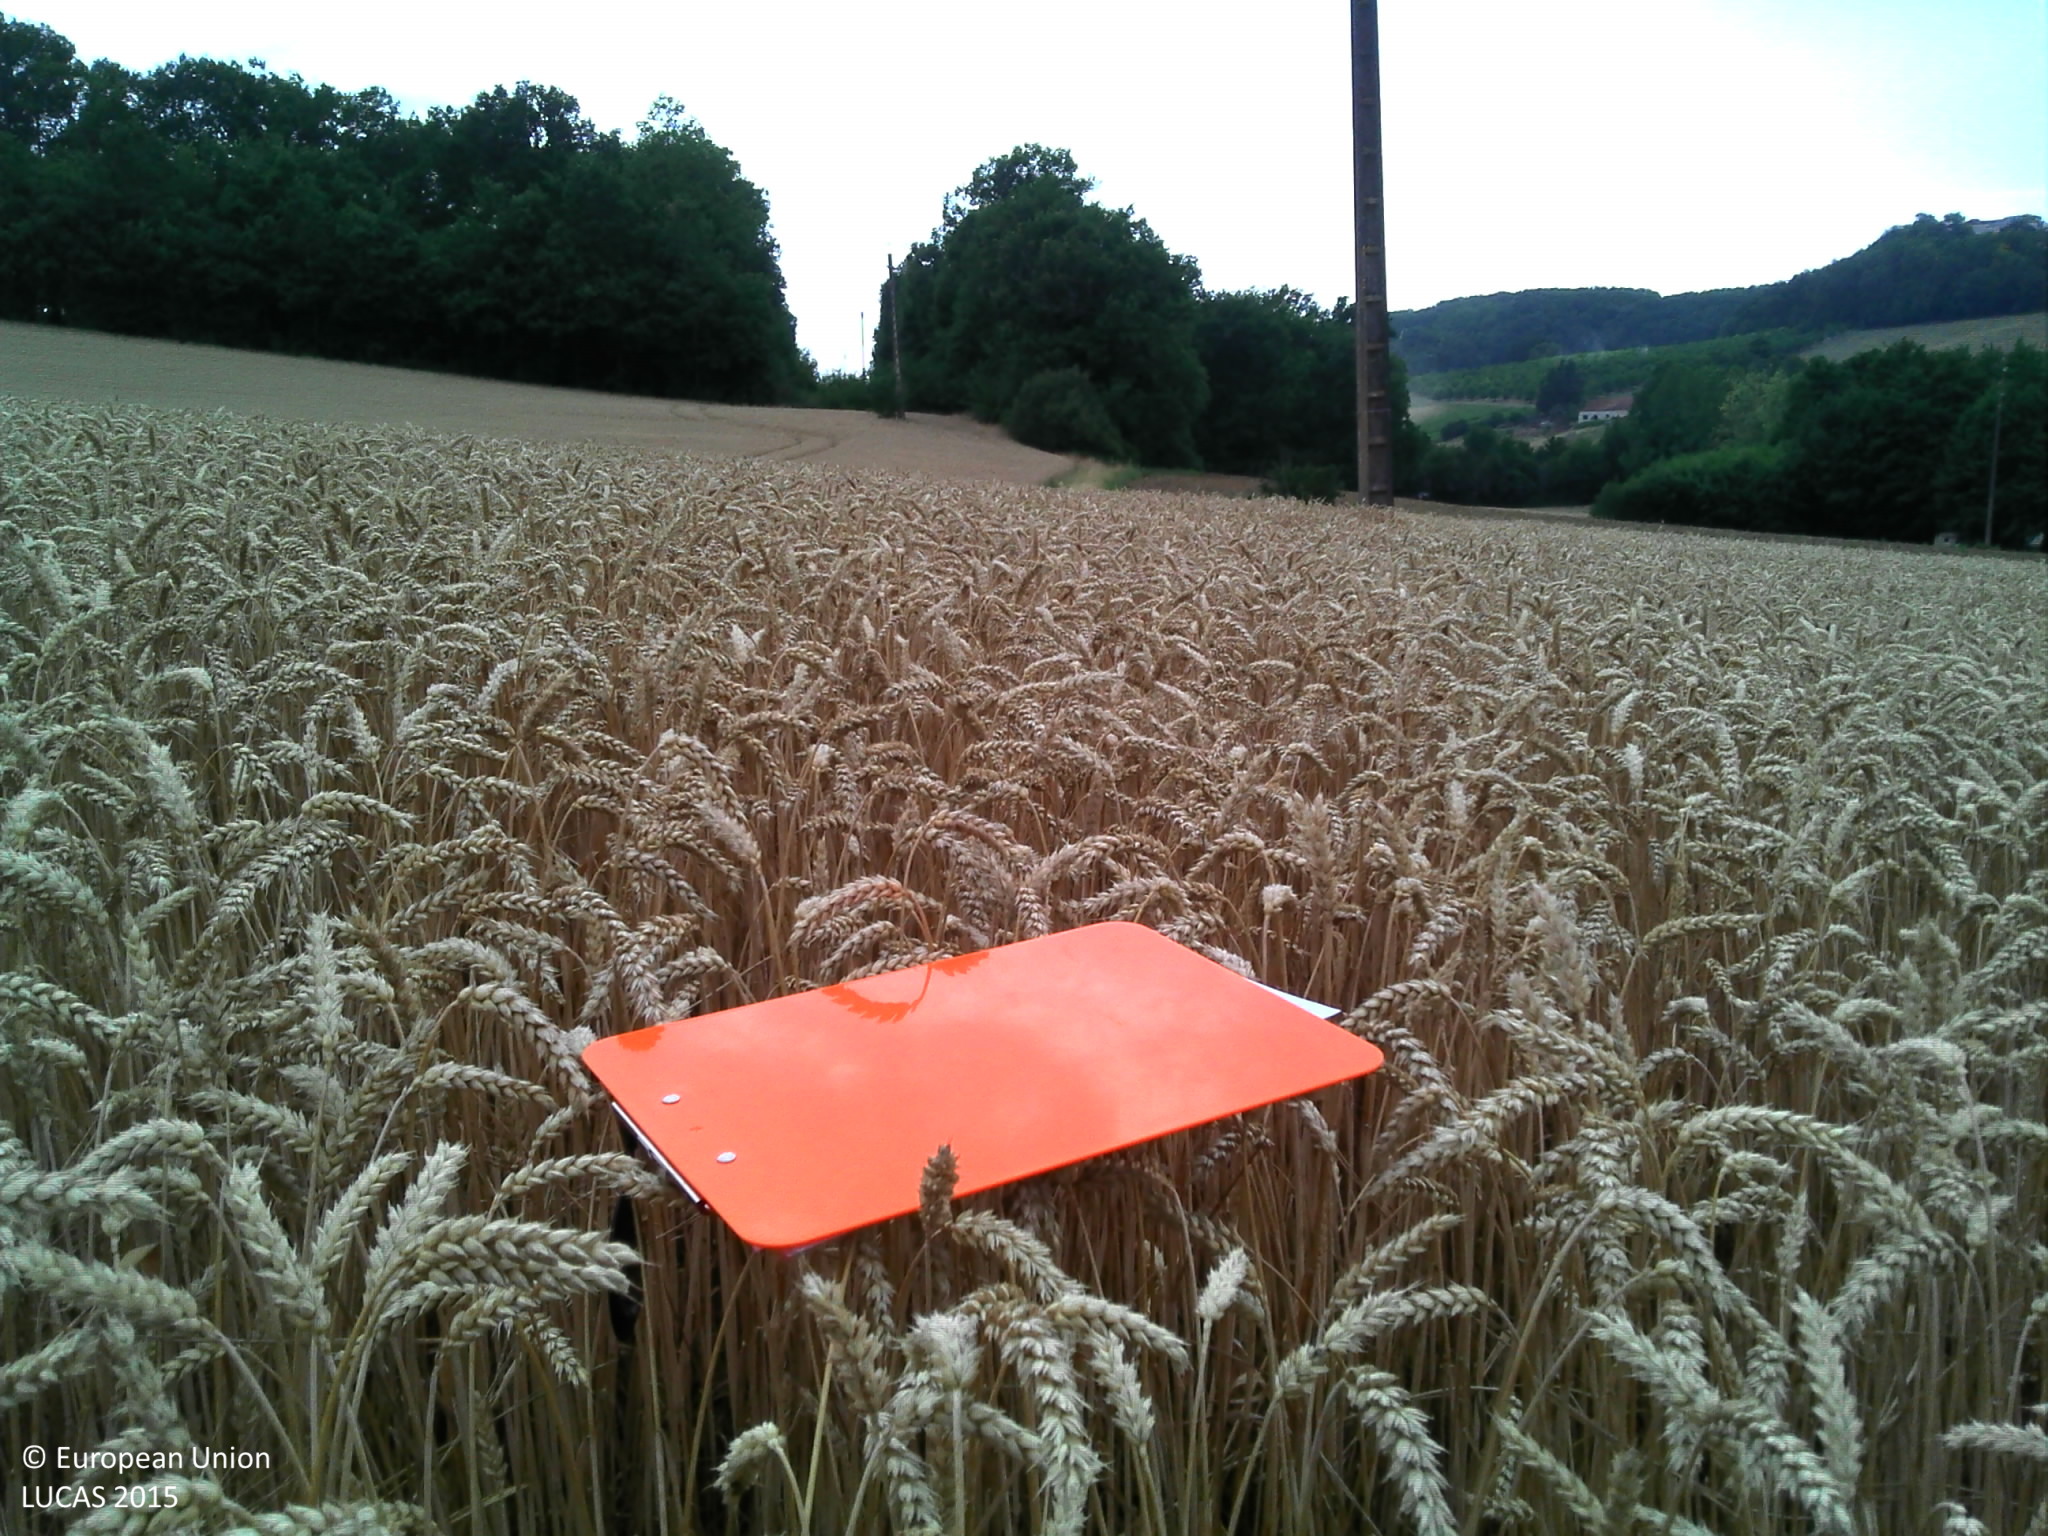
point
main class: Cropland
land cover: Common wheat
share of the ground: > 75 %
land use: Agriculture (excluding fallow land and kitchen gardens)
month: July
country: FR
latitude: 44.3426
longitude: 0.8261
